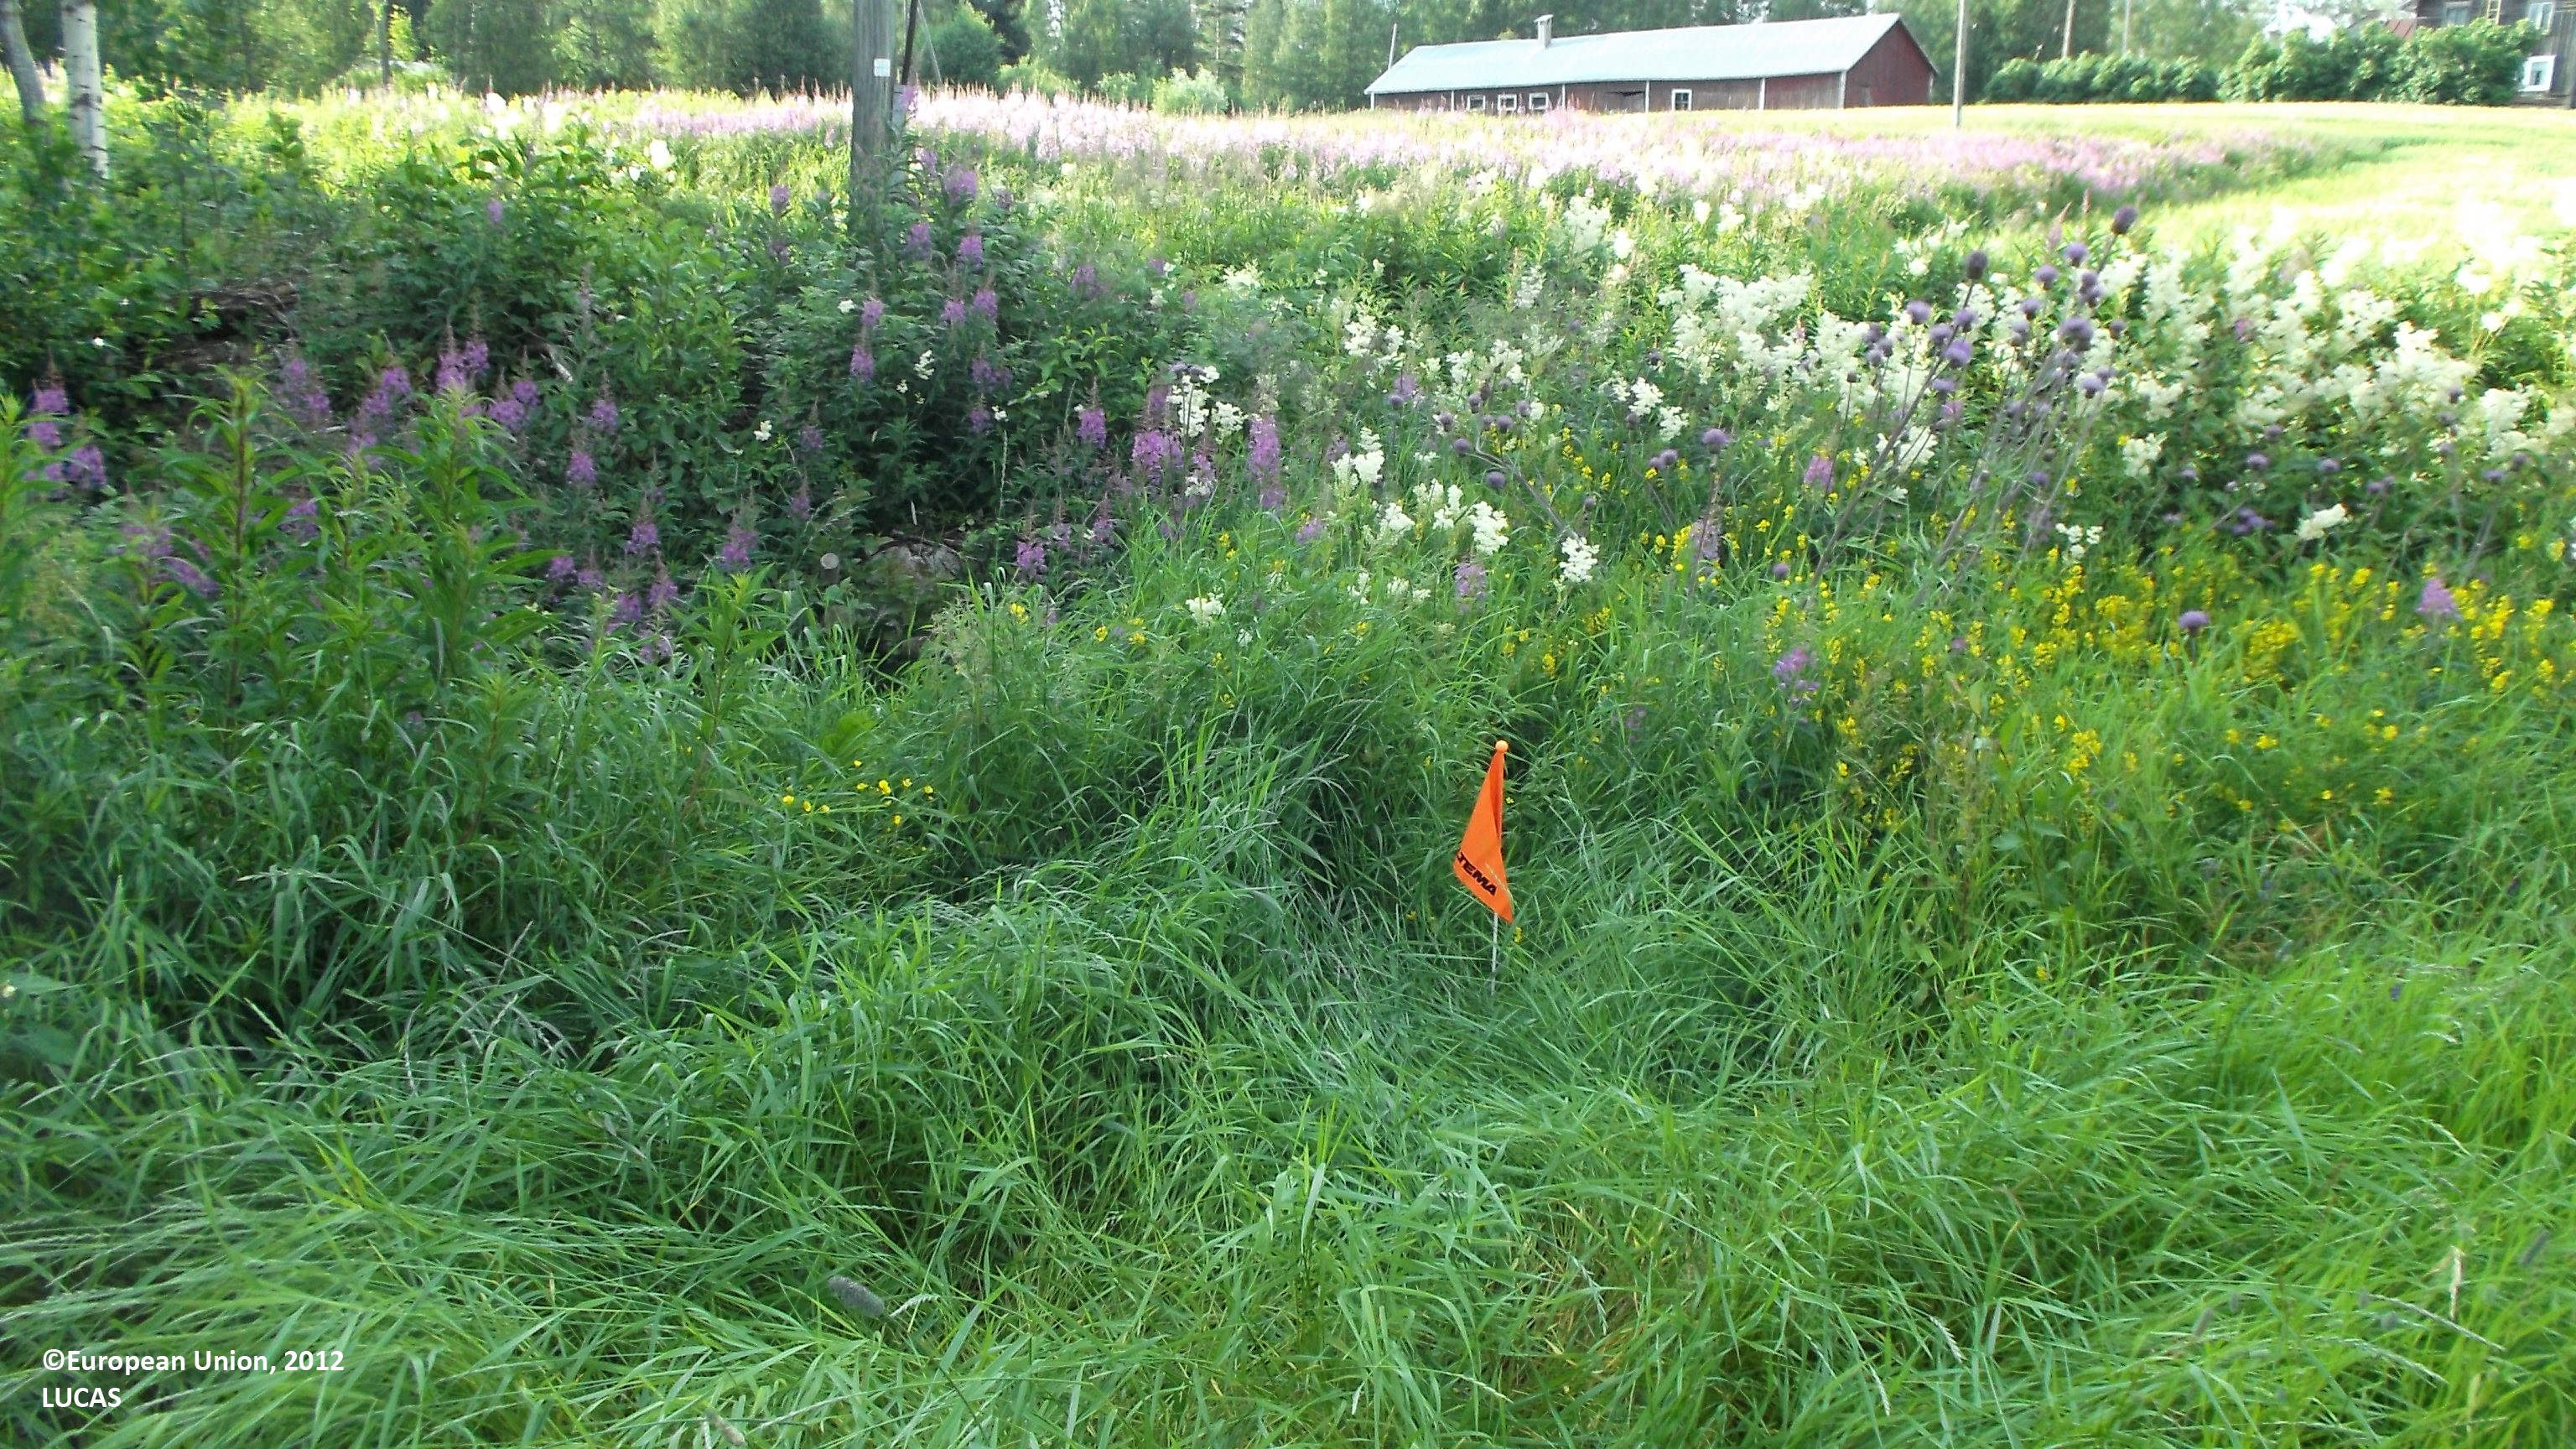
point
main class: Grassland
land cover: Grassland without tree/shrub cover
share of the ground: 50 - 75 %
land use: Fallow land
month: July
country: FI
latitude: 63.6430
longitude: 24.0199
